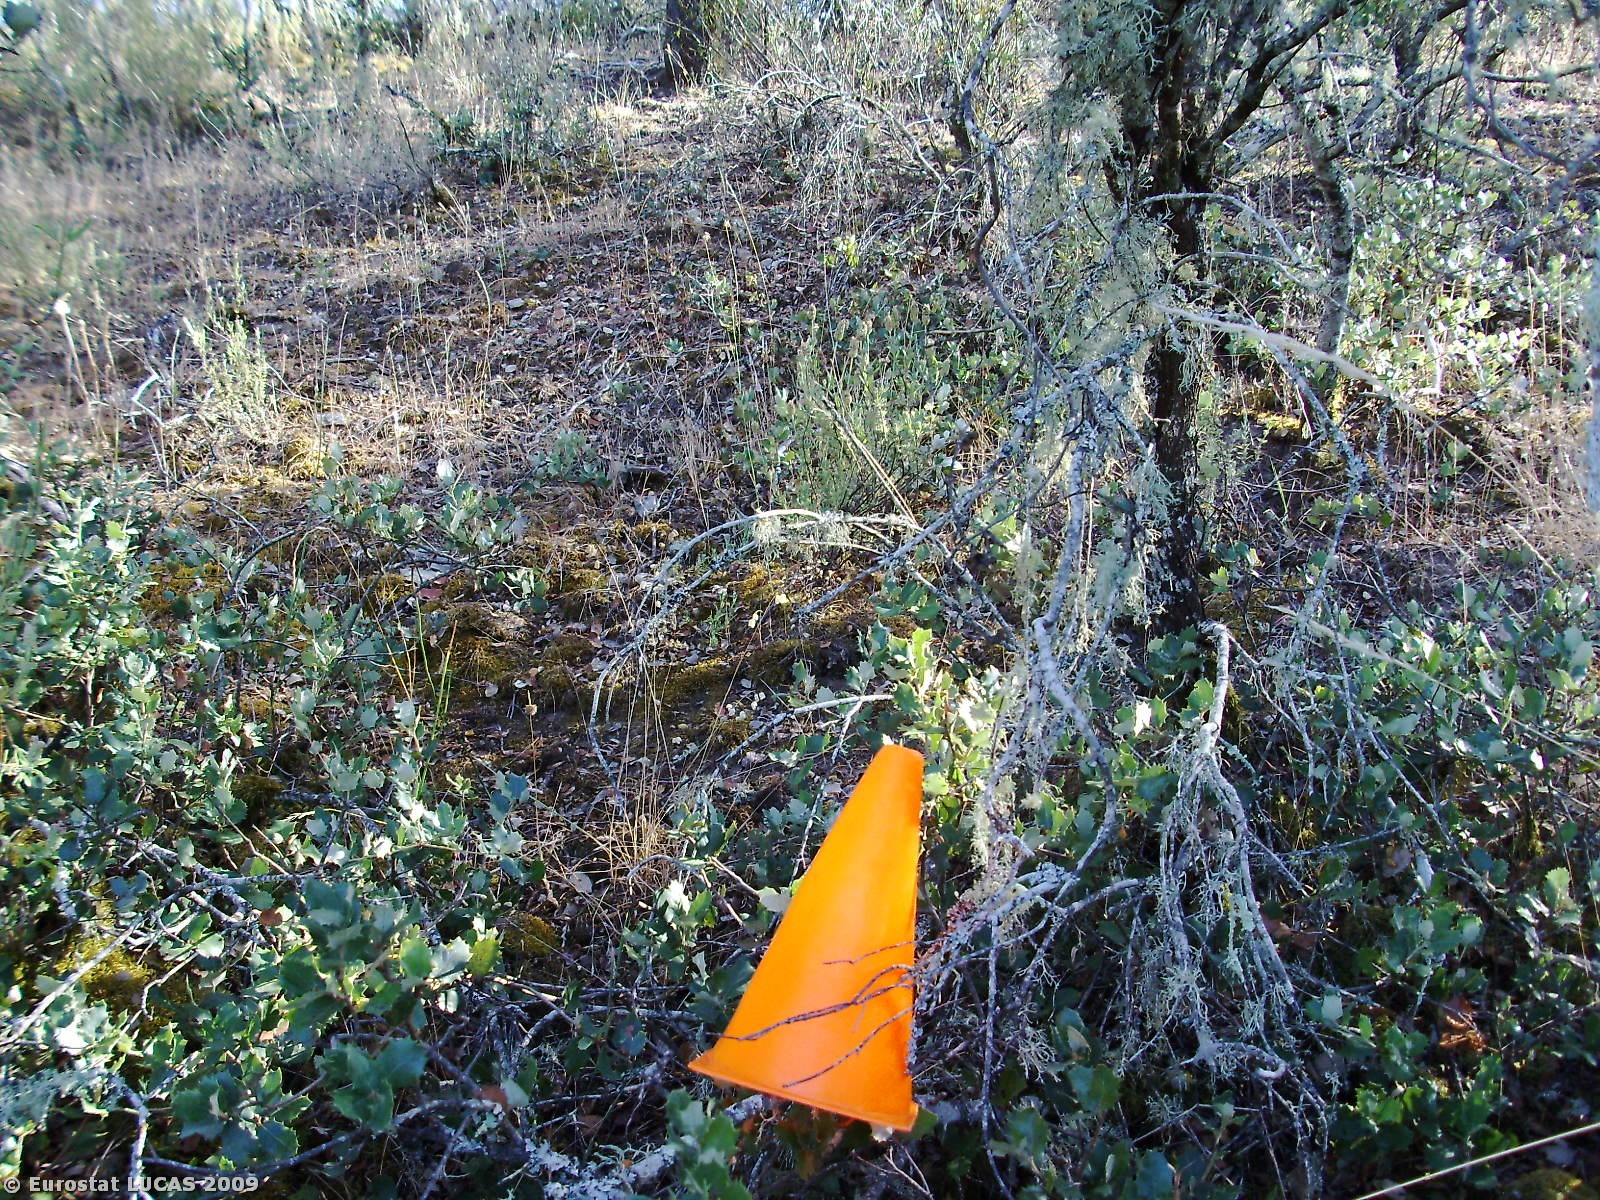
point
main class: Woodland
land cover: Broadleaved woodland
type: broadleaved evergreen forest
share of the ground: 25 - 50 %
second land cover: Shrubland with sparse tree cover
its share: 50 - 75 %
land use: Forestry
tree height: > 5 m
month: April
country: PT
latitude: 39.5281
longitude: -7.5096
